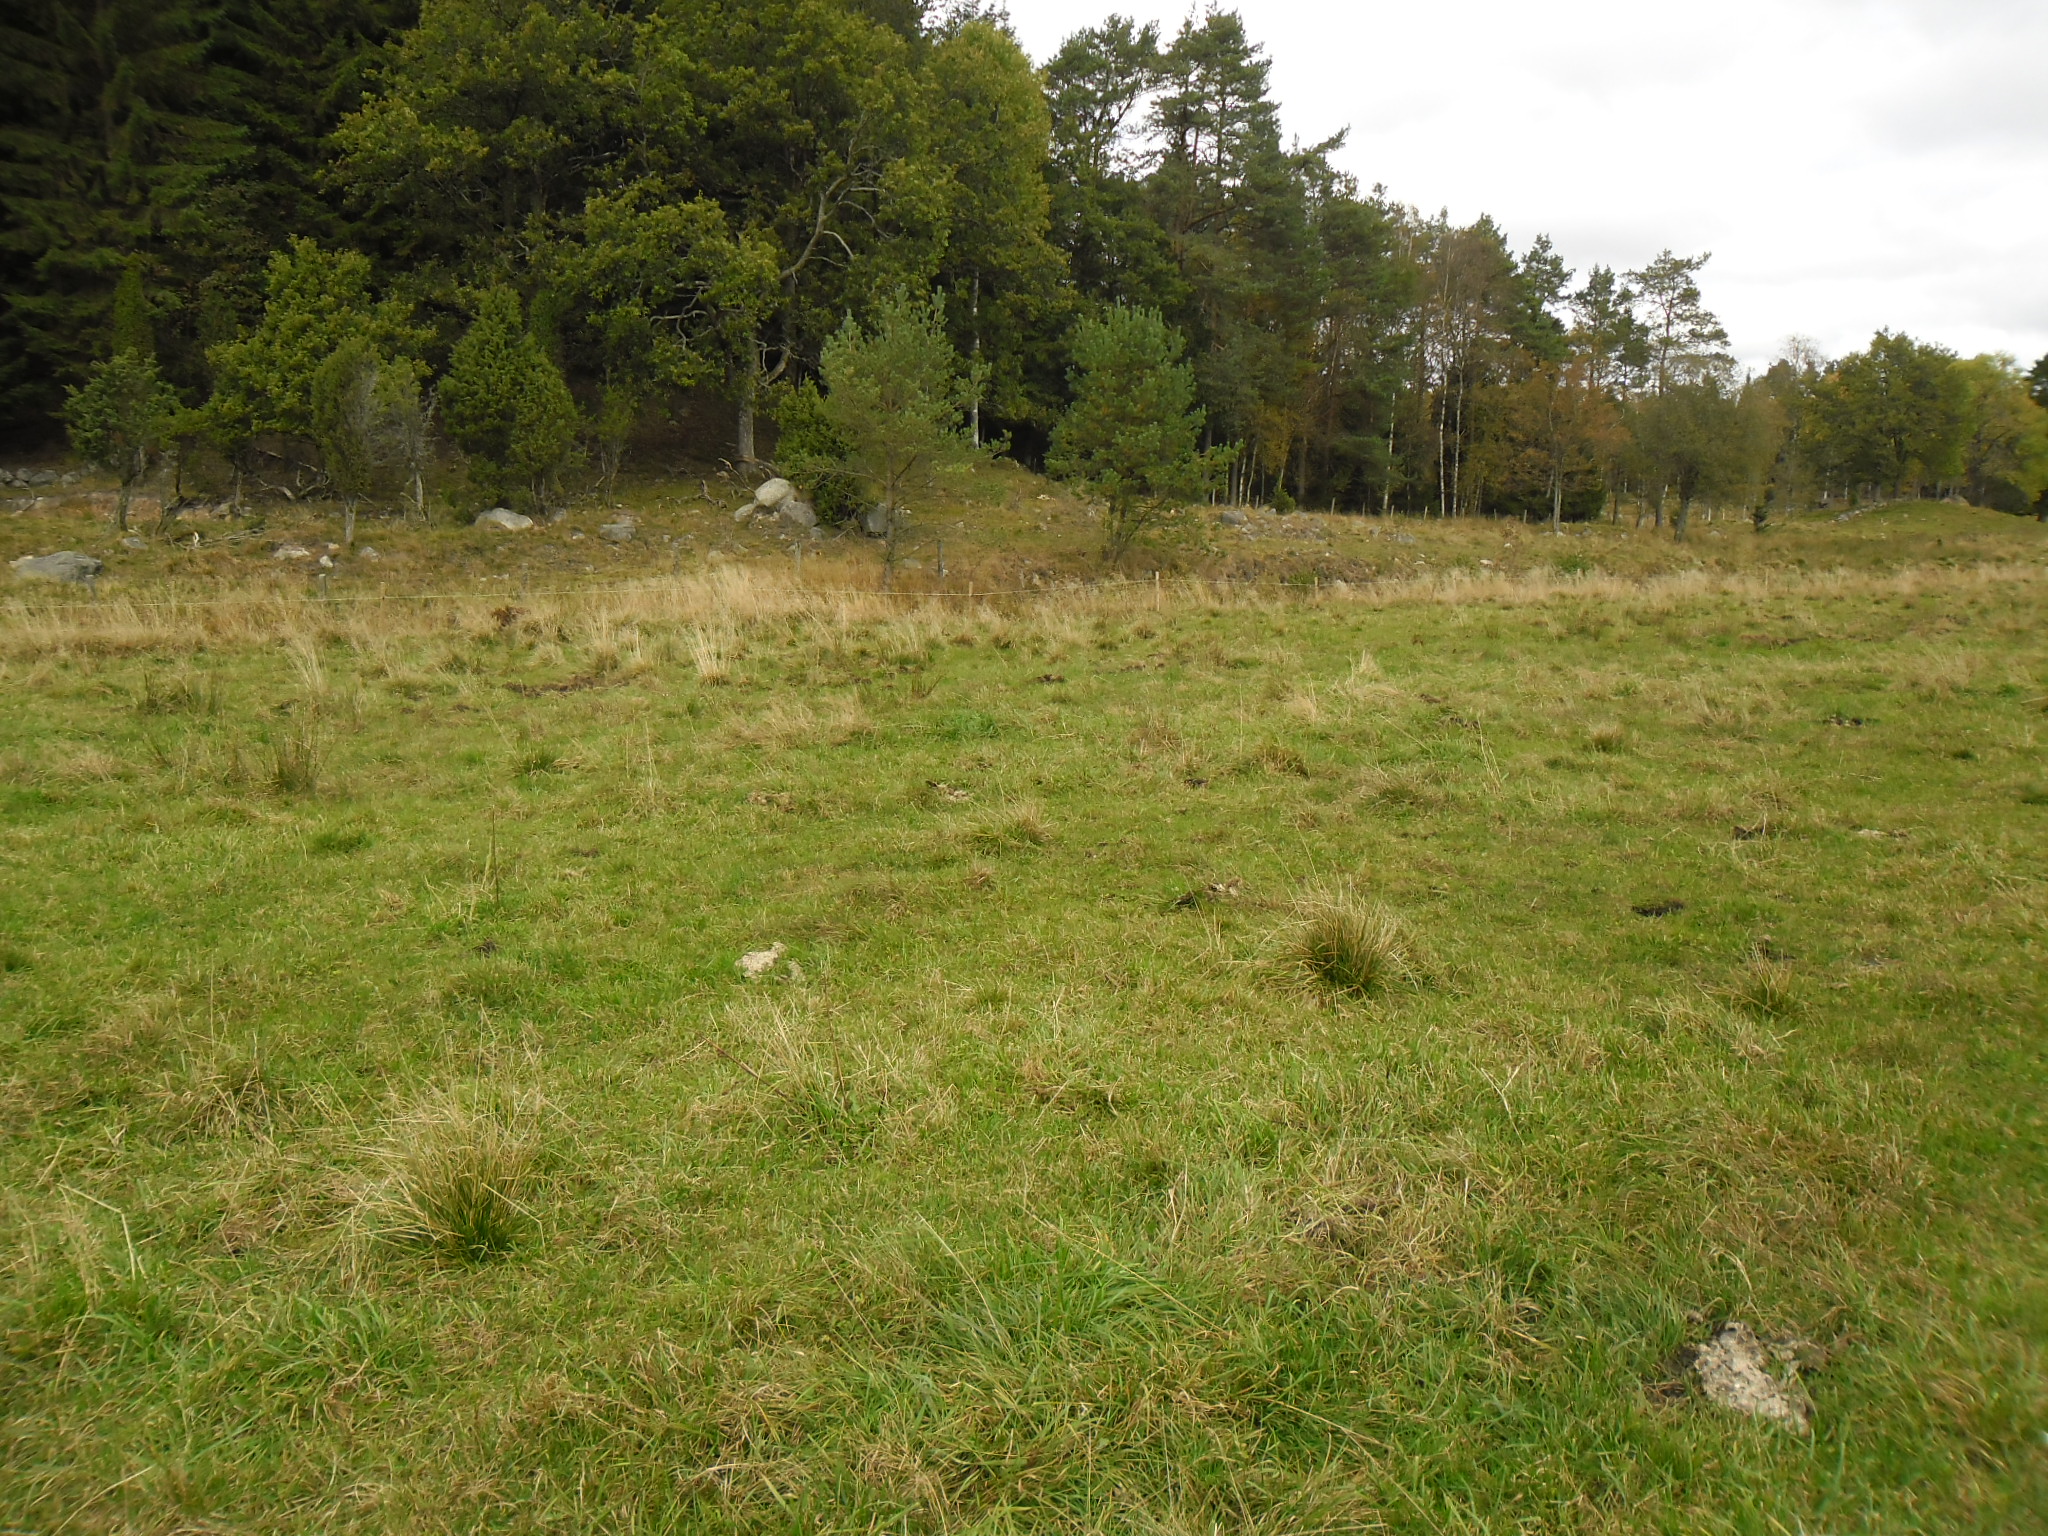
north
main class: Grassland
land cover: Grassland without tree/shrub cover
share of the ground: > 75 %
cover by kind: herbaceous plants 100 %
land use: Agriculture (excluding fallow land and kitchen gardens)
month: October
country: SE
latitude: 56.7061
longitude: 13.1819
